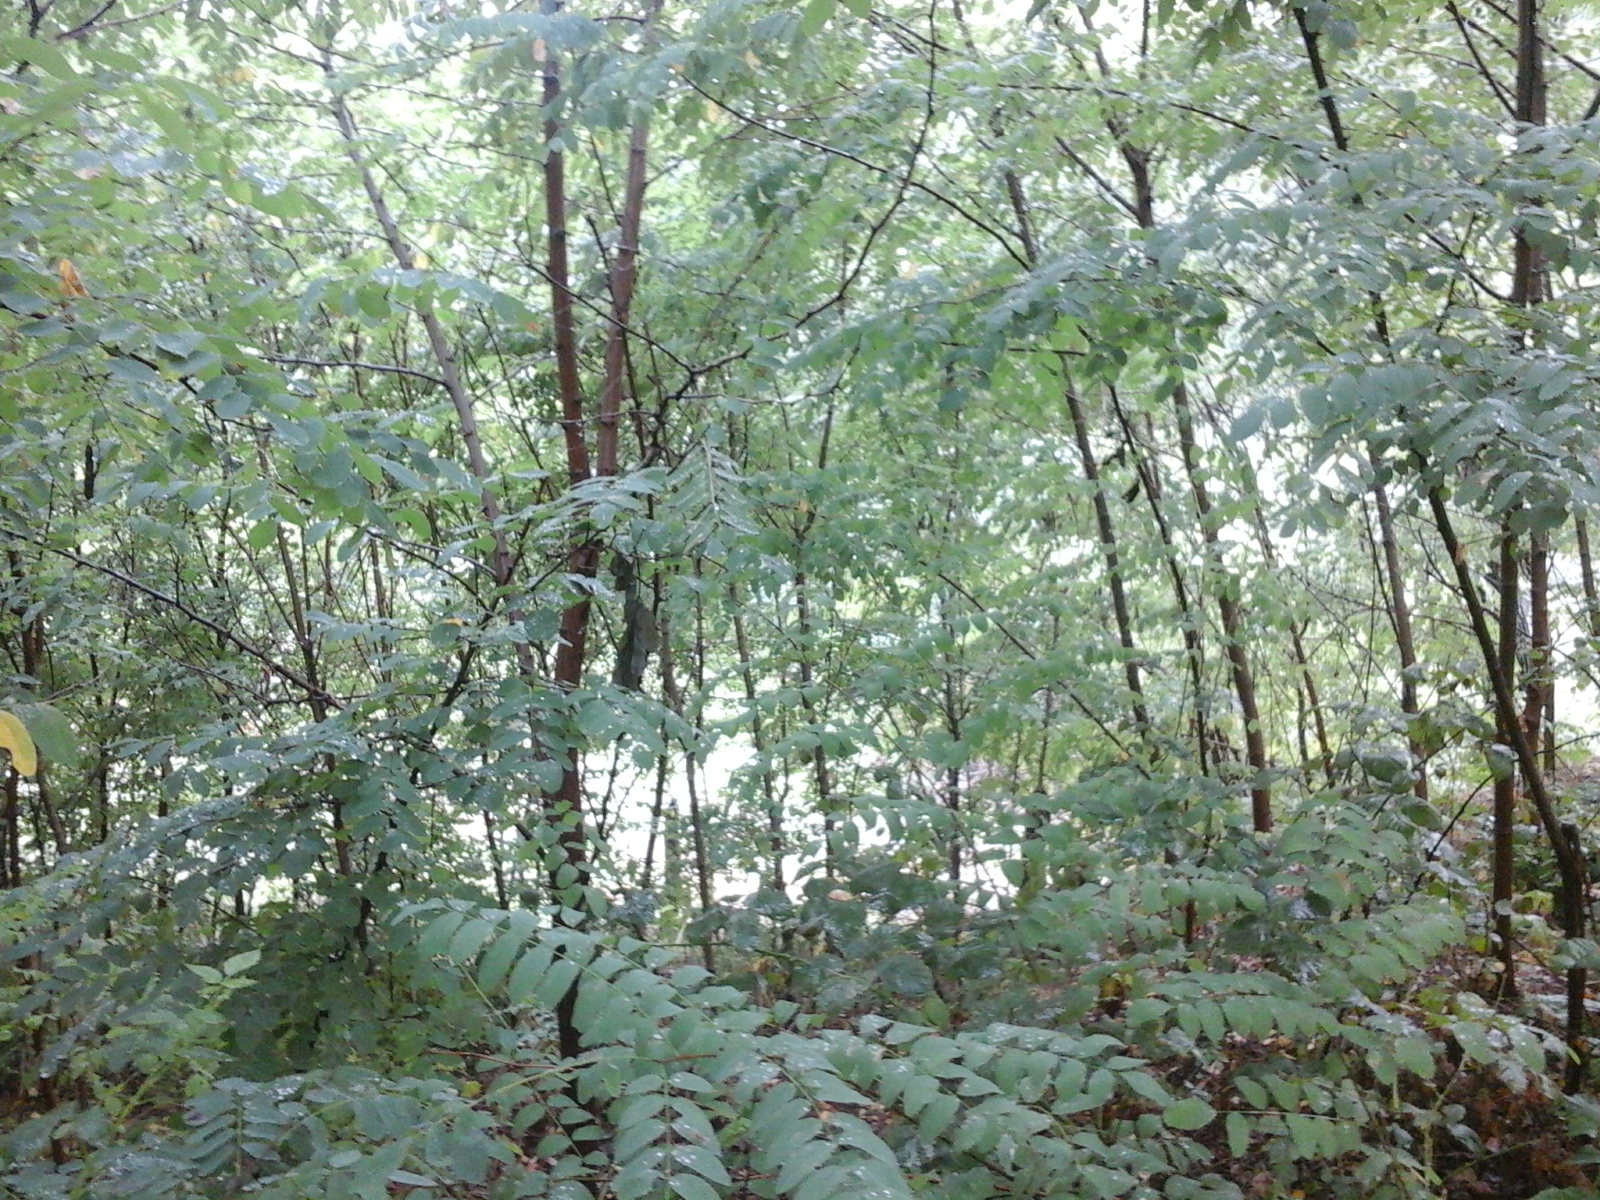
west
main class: Woodland
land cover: Broadleaved woodland
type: exotic forest
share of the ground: > 75 %
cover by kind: broadleaved forest trees 100 %
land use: Forestry
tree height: > 5 m
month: September
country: RO
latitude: 45.0192
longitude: 23.7544
